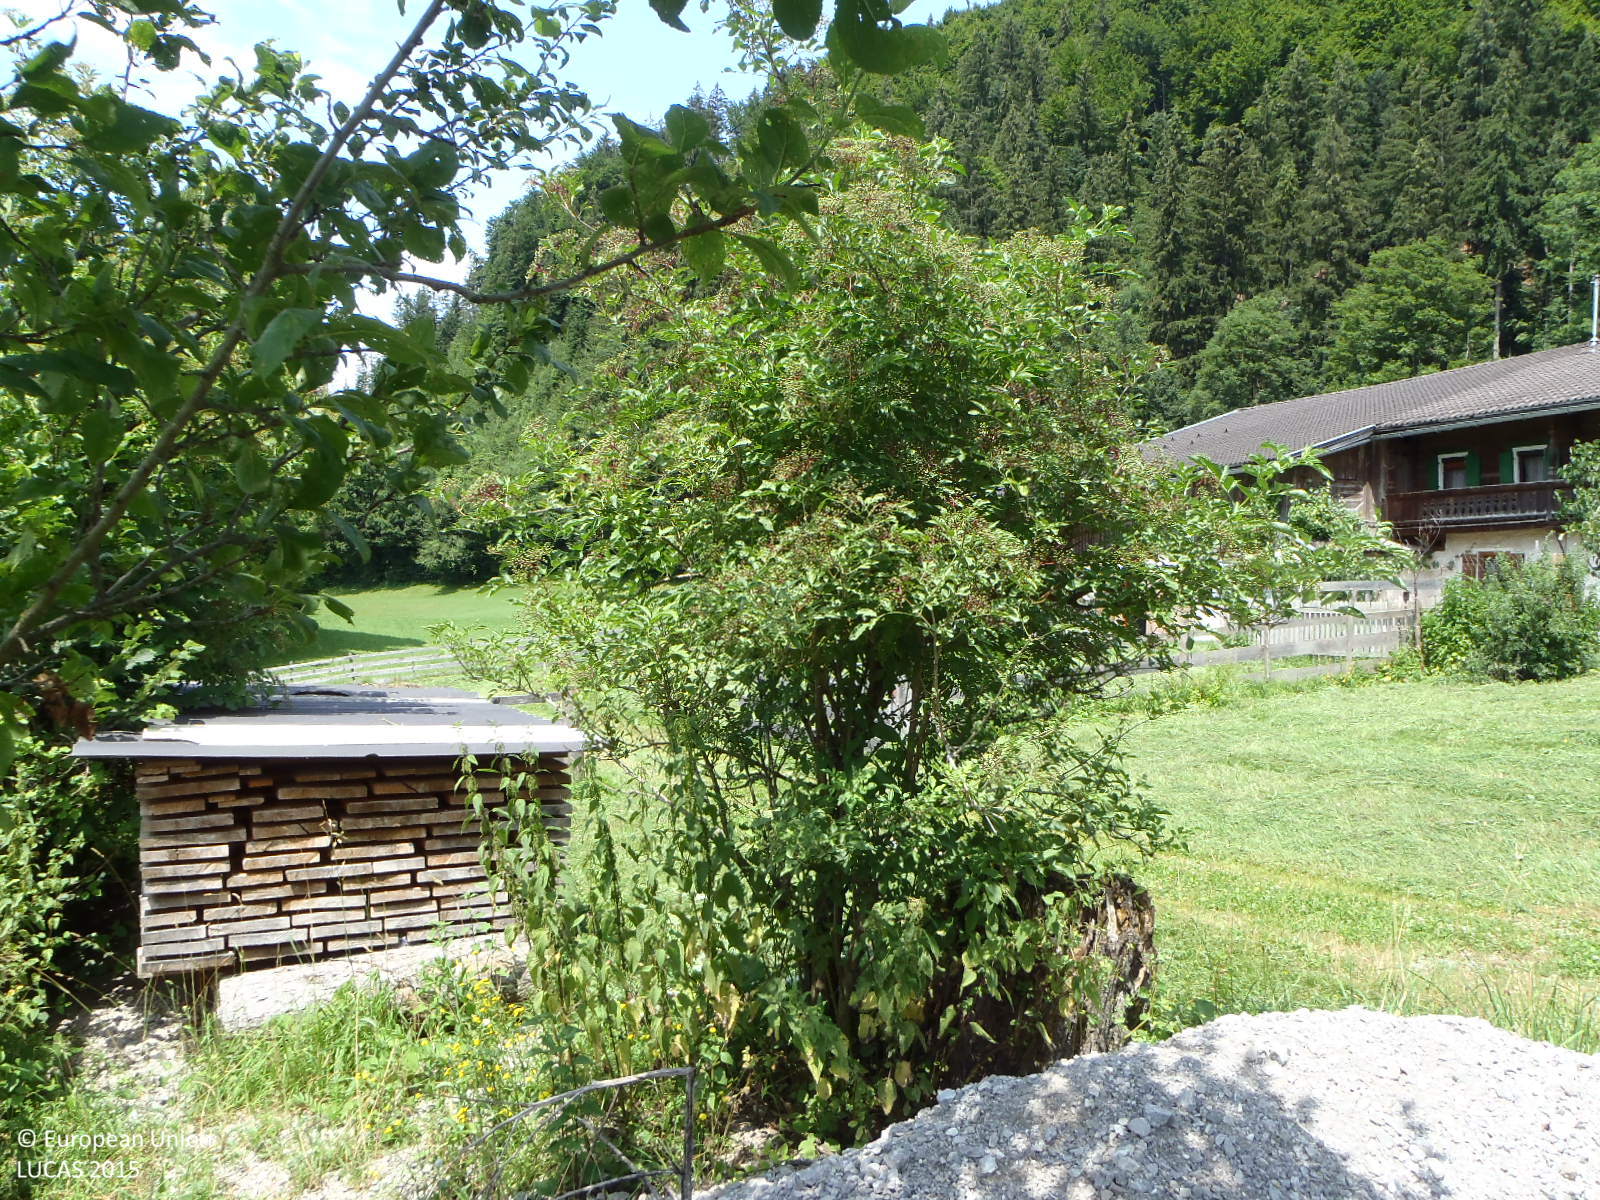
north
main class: Grassland
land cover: Grassland without tree/shrub cover
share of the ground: > 75 %
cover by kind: herbaceous plants 100 %
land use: Agriculture (excluding fallow land and kitchen gardens)
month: July
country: AT
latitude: 47.5542
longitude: 12.1646
